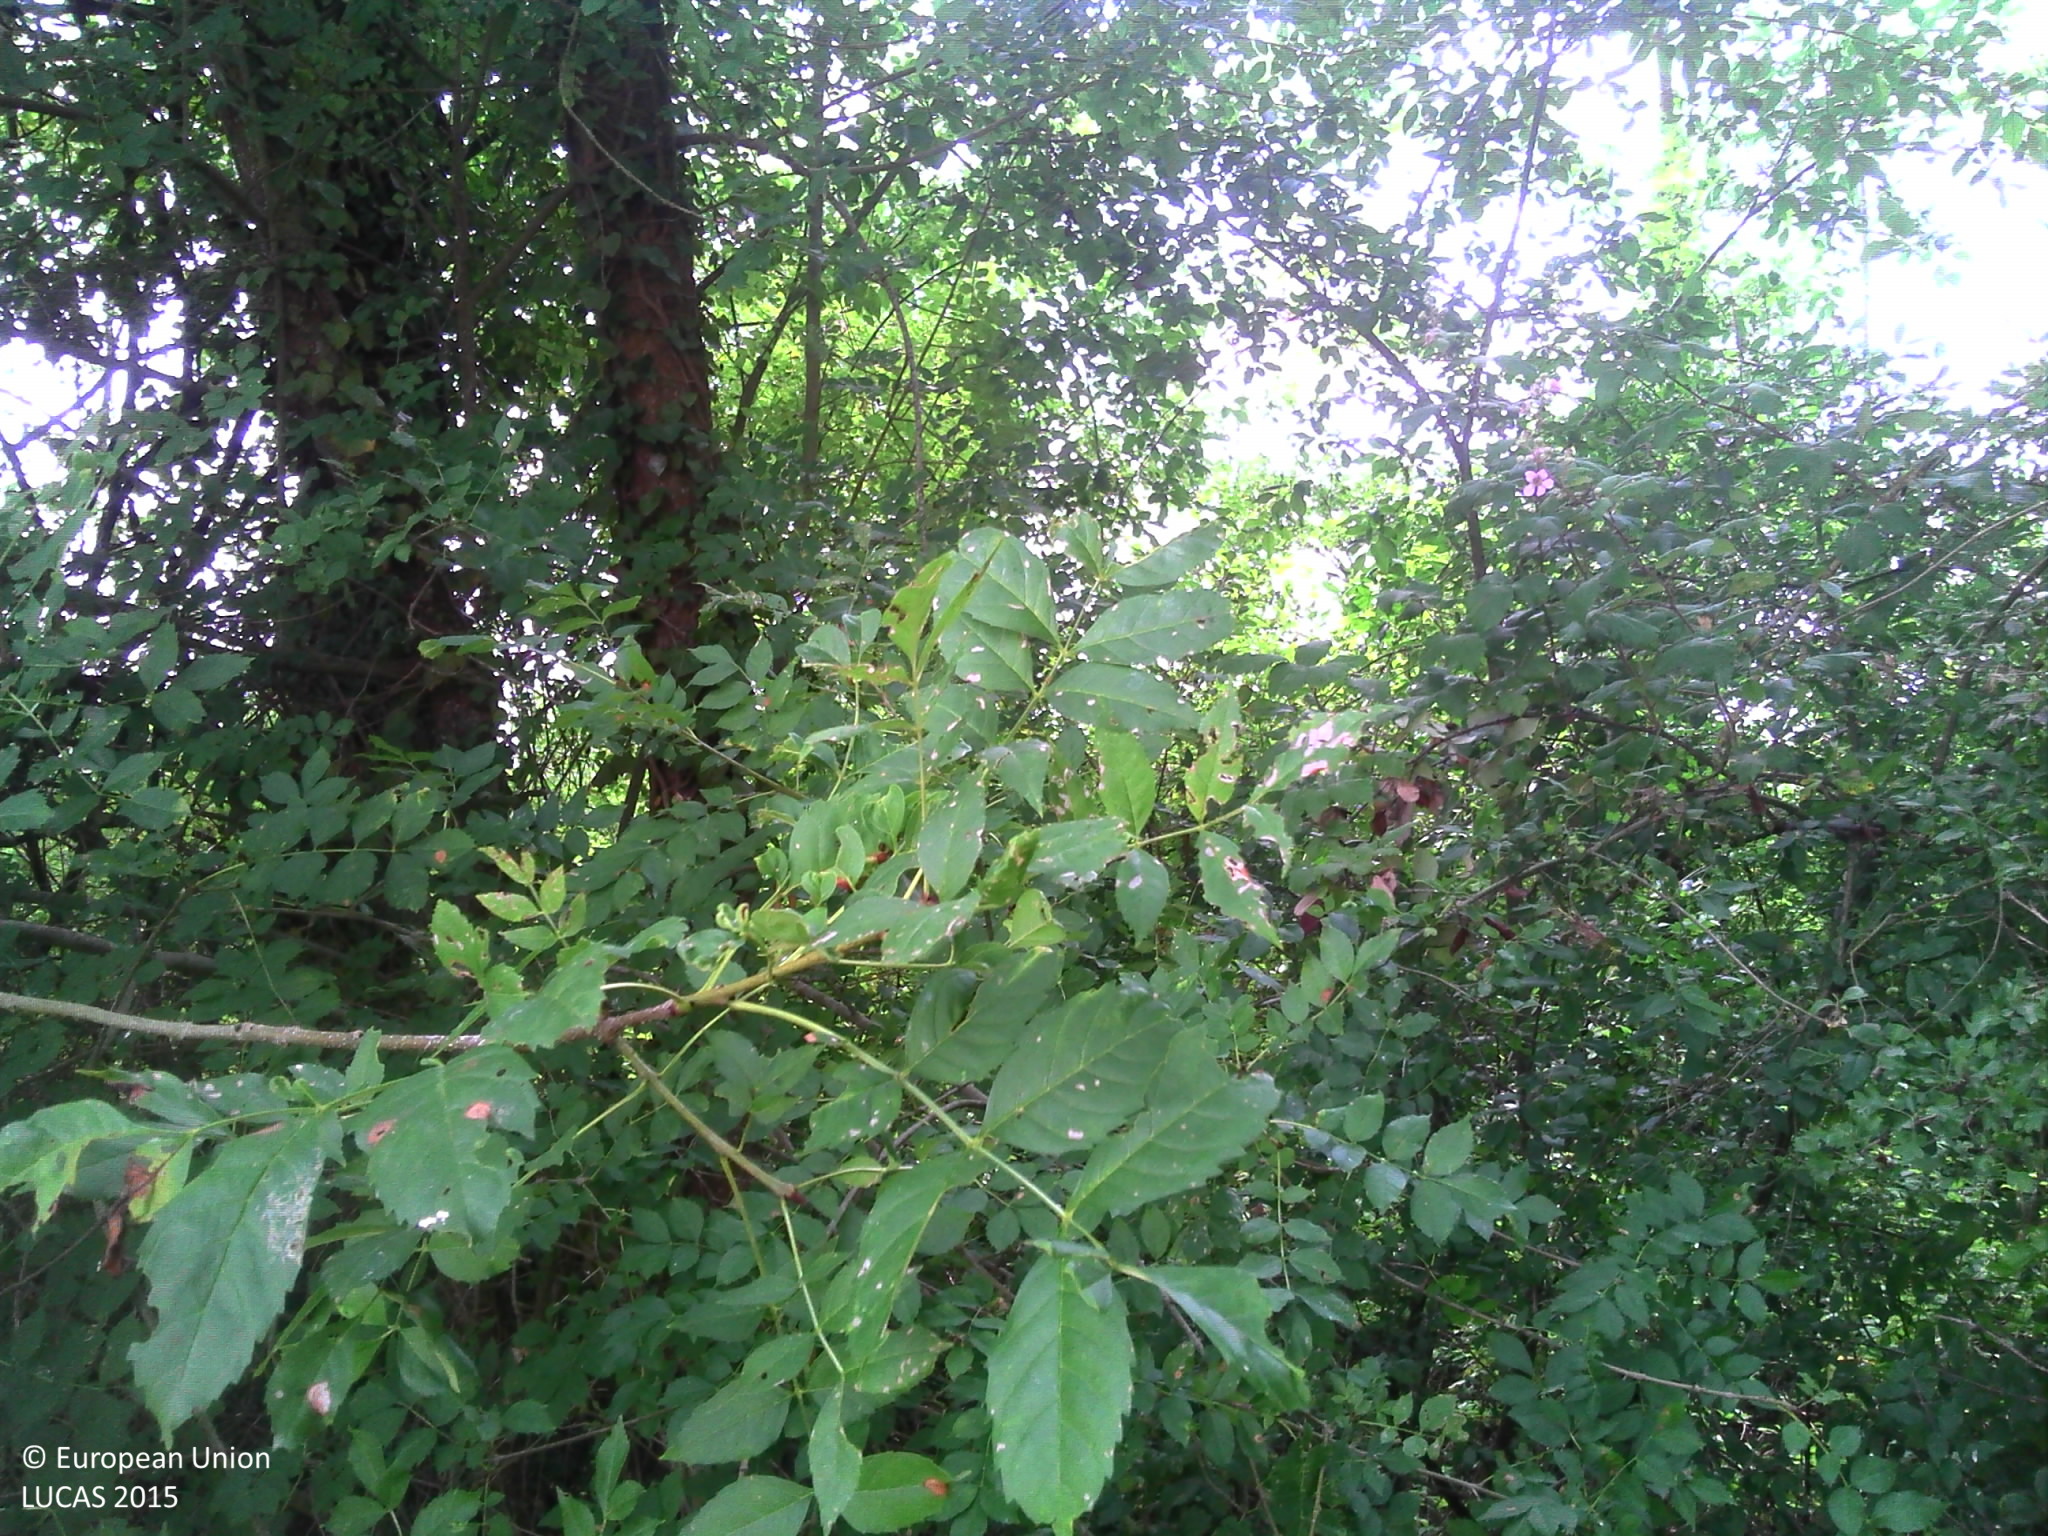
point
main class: Woodland
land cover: Broadleaved woodland
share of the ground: > 75 %
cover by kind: broadleaved forest trees 65 %, shrubs 35 %
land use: Forestry
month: July
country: FR
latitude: 47.2742
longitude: 0.1548
